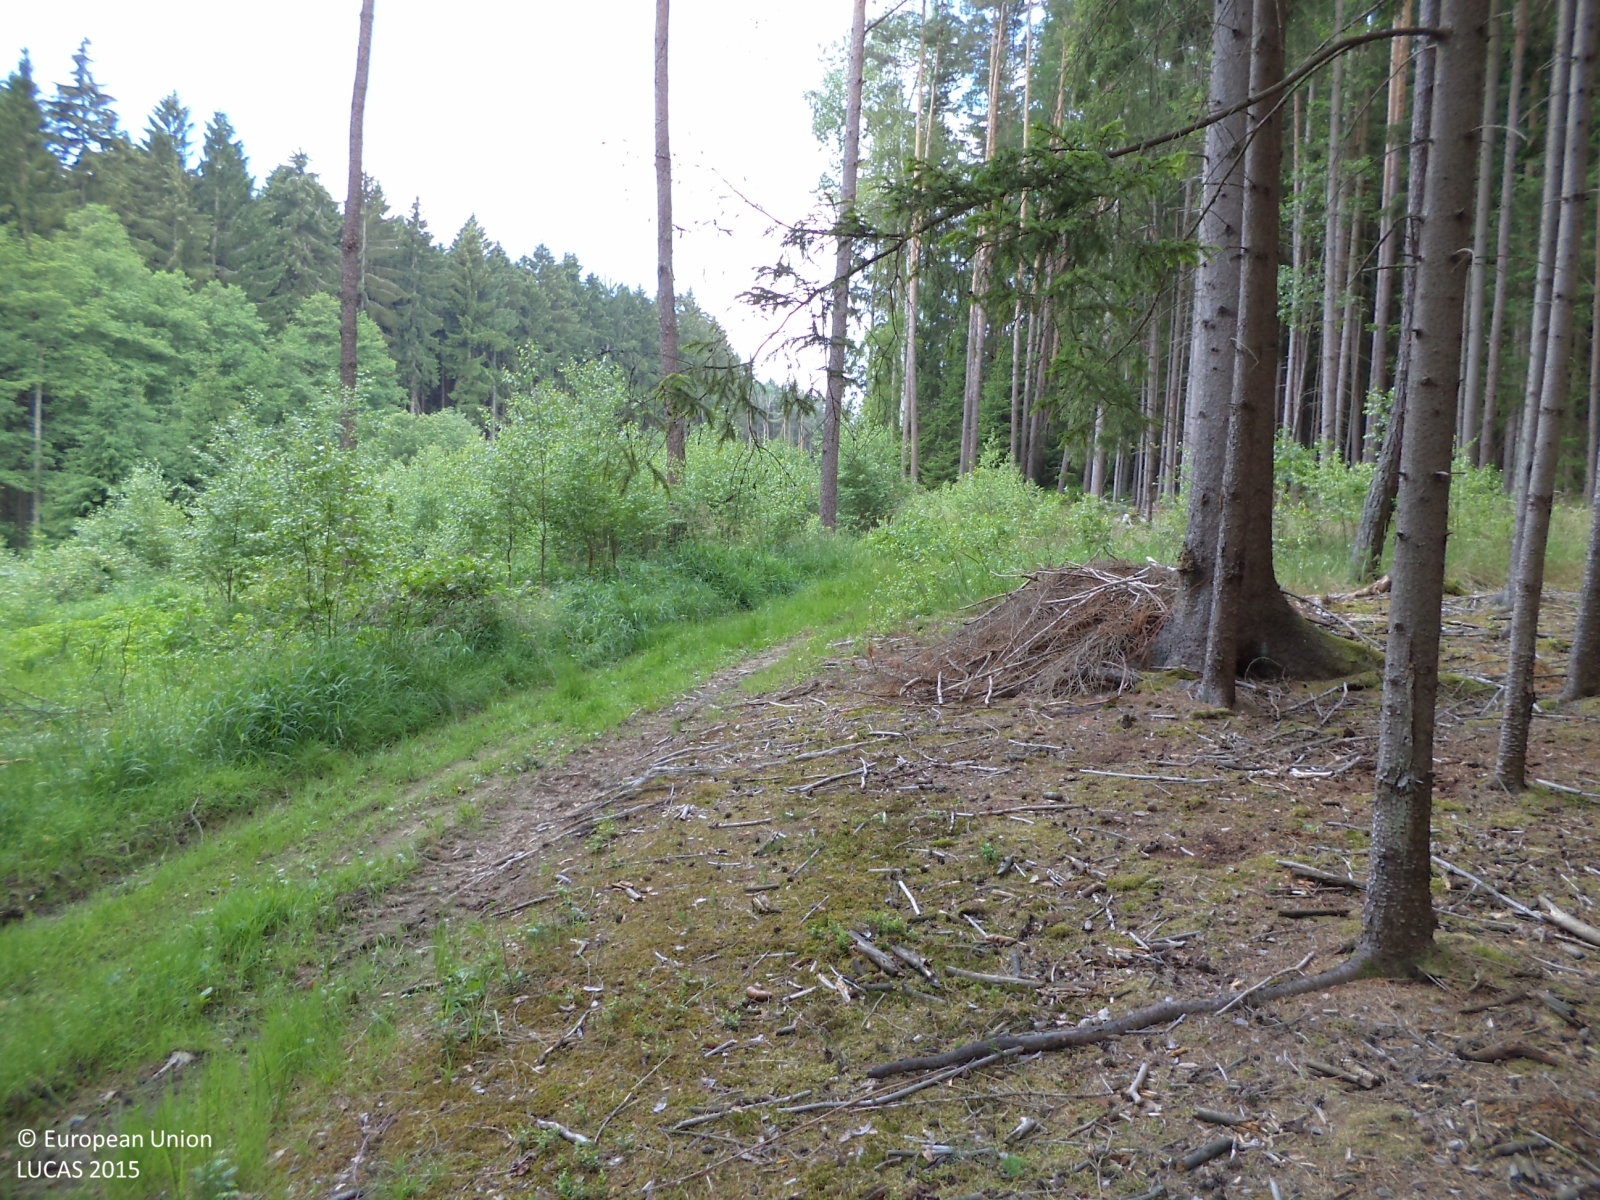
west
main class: Woodland
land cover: Pine dominated coniferous woodland
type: hemiboreal forest and nemoral coniferous forest and mixed broadleaved-coniferous forest
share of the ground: > 75 %
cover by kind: coniferous forest trees 80 %, herbaceous plants 10 %, lichens and mosses 10 %
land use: Forestry
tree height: > 5 m
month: June
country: CZ
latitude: 49.3524
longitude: 14.6134
